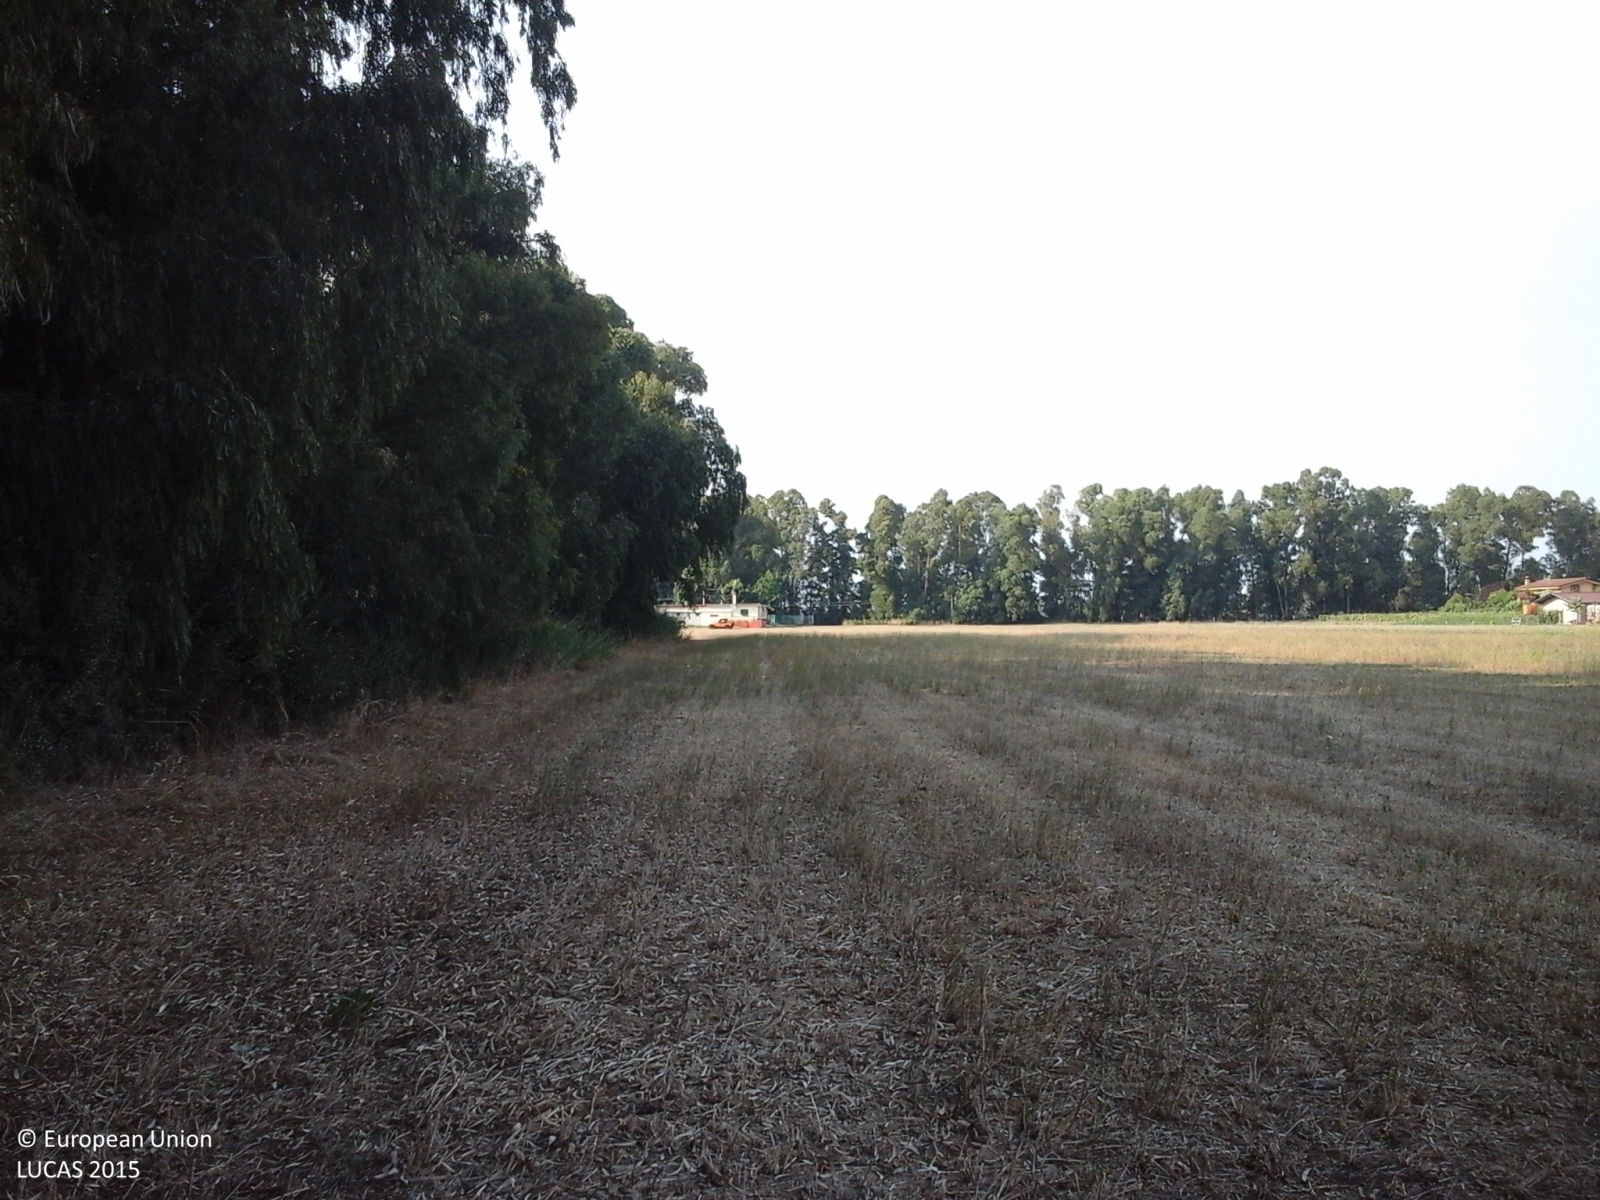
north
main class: Cropland
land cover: Temporary grasslands
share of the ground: > 75 %
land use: Agriculture (excluding fallow land and kitchen gardens)
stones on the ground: < 10 %
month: July
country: IT
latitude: 41.4762
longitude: 12.8029
